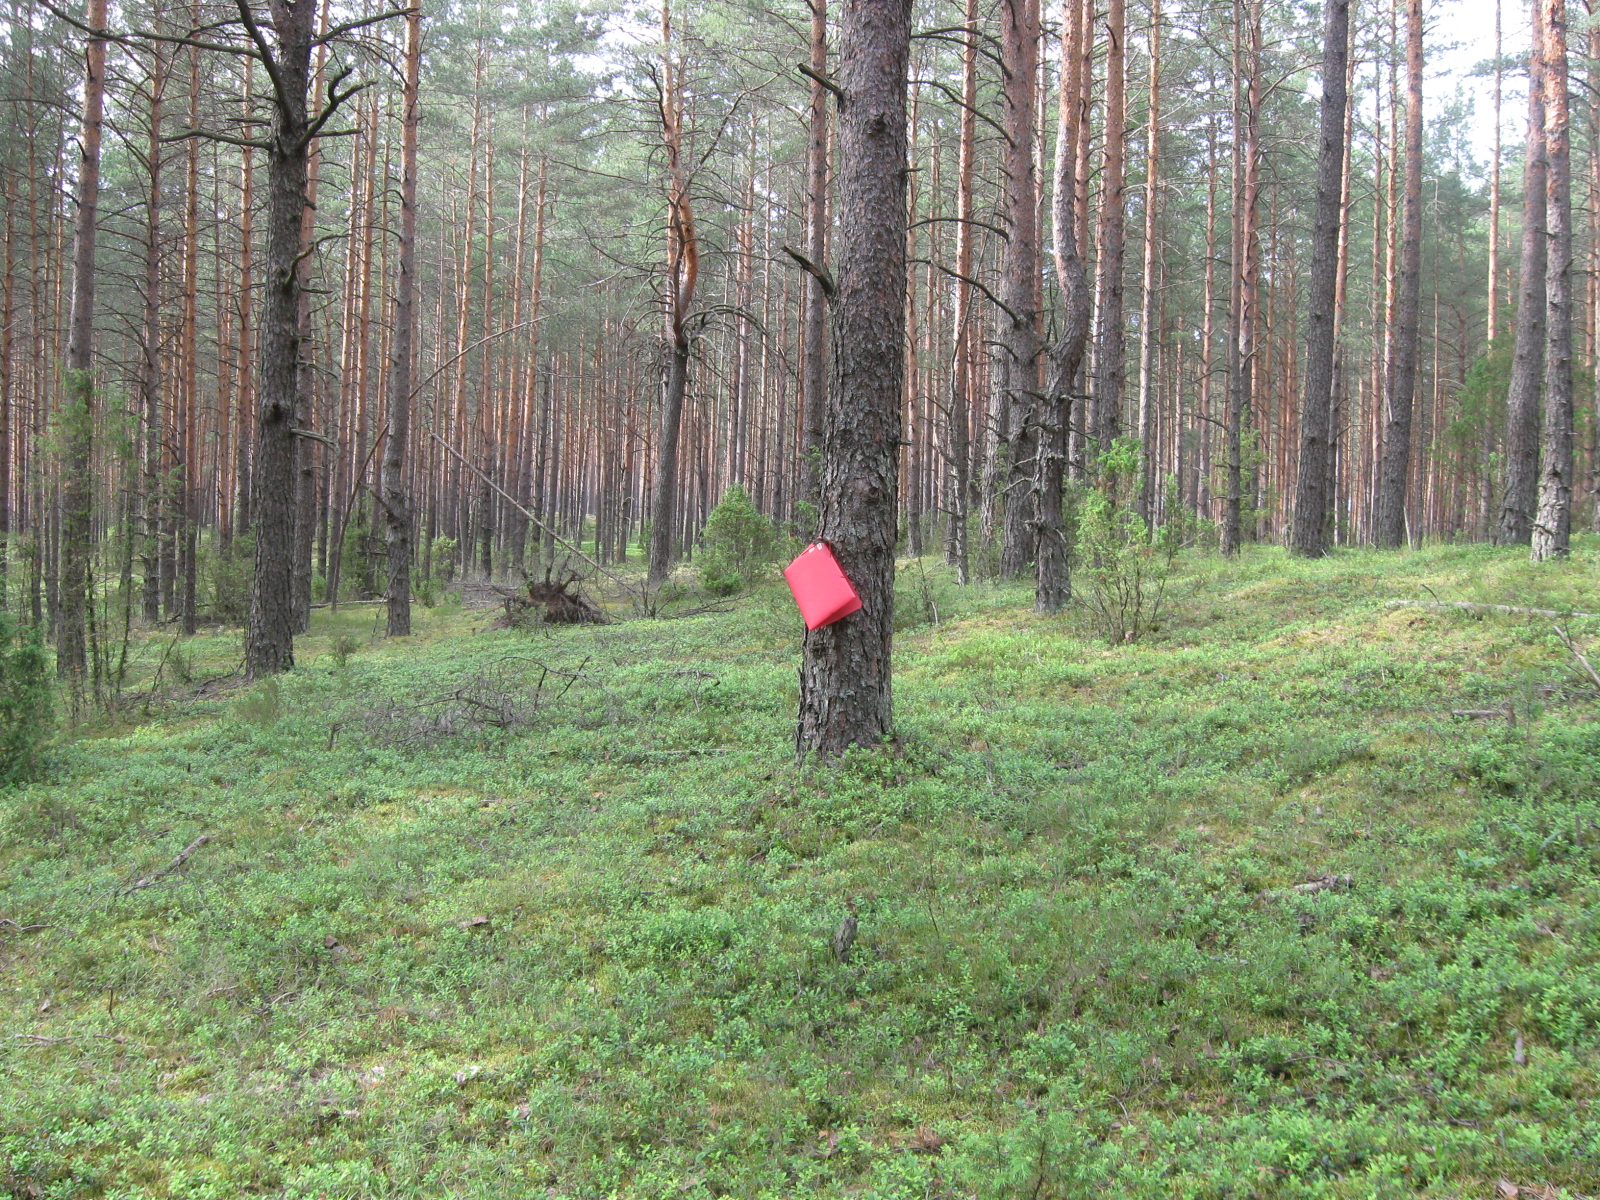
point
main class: Woodland
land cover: Pine dominated coniferous woodland
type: hemiboreal forest and nemoral coniferous forest and mixed broadleaved-coniferous forest
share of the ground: > 75 %
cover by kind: coniferous forest trees 80 %, lichens and mosses 15 %, herbaceous plants 5 %
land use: Forestry
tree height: > 5 m
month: June
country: LT
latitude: 54.2084
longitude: 24.6263
